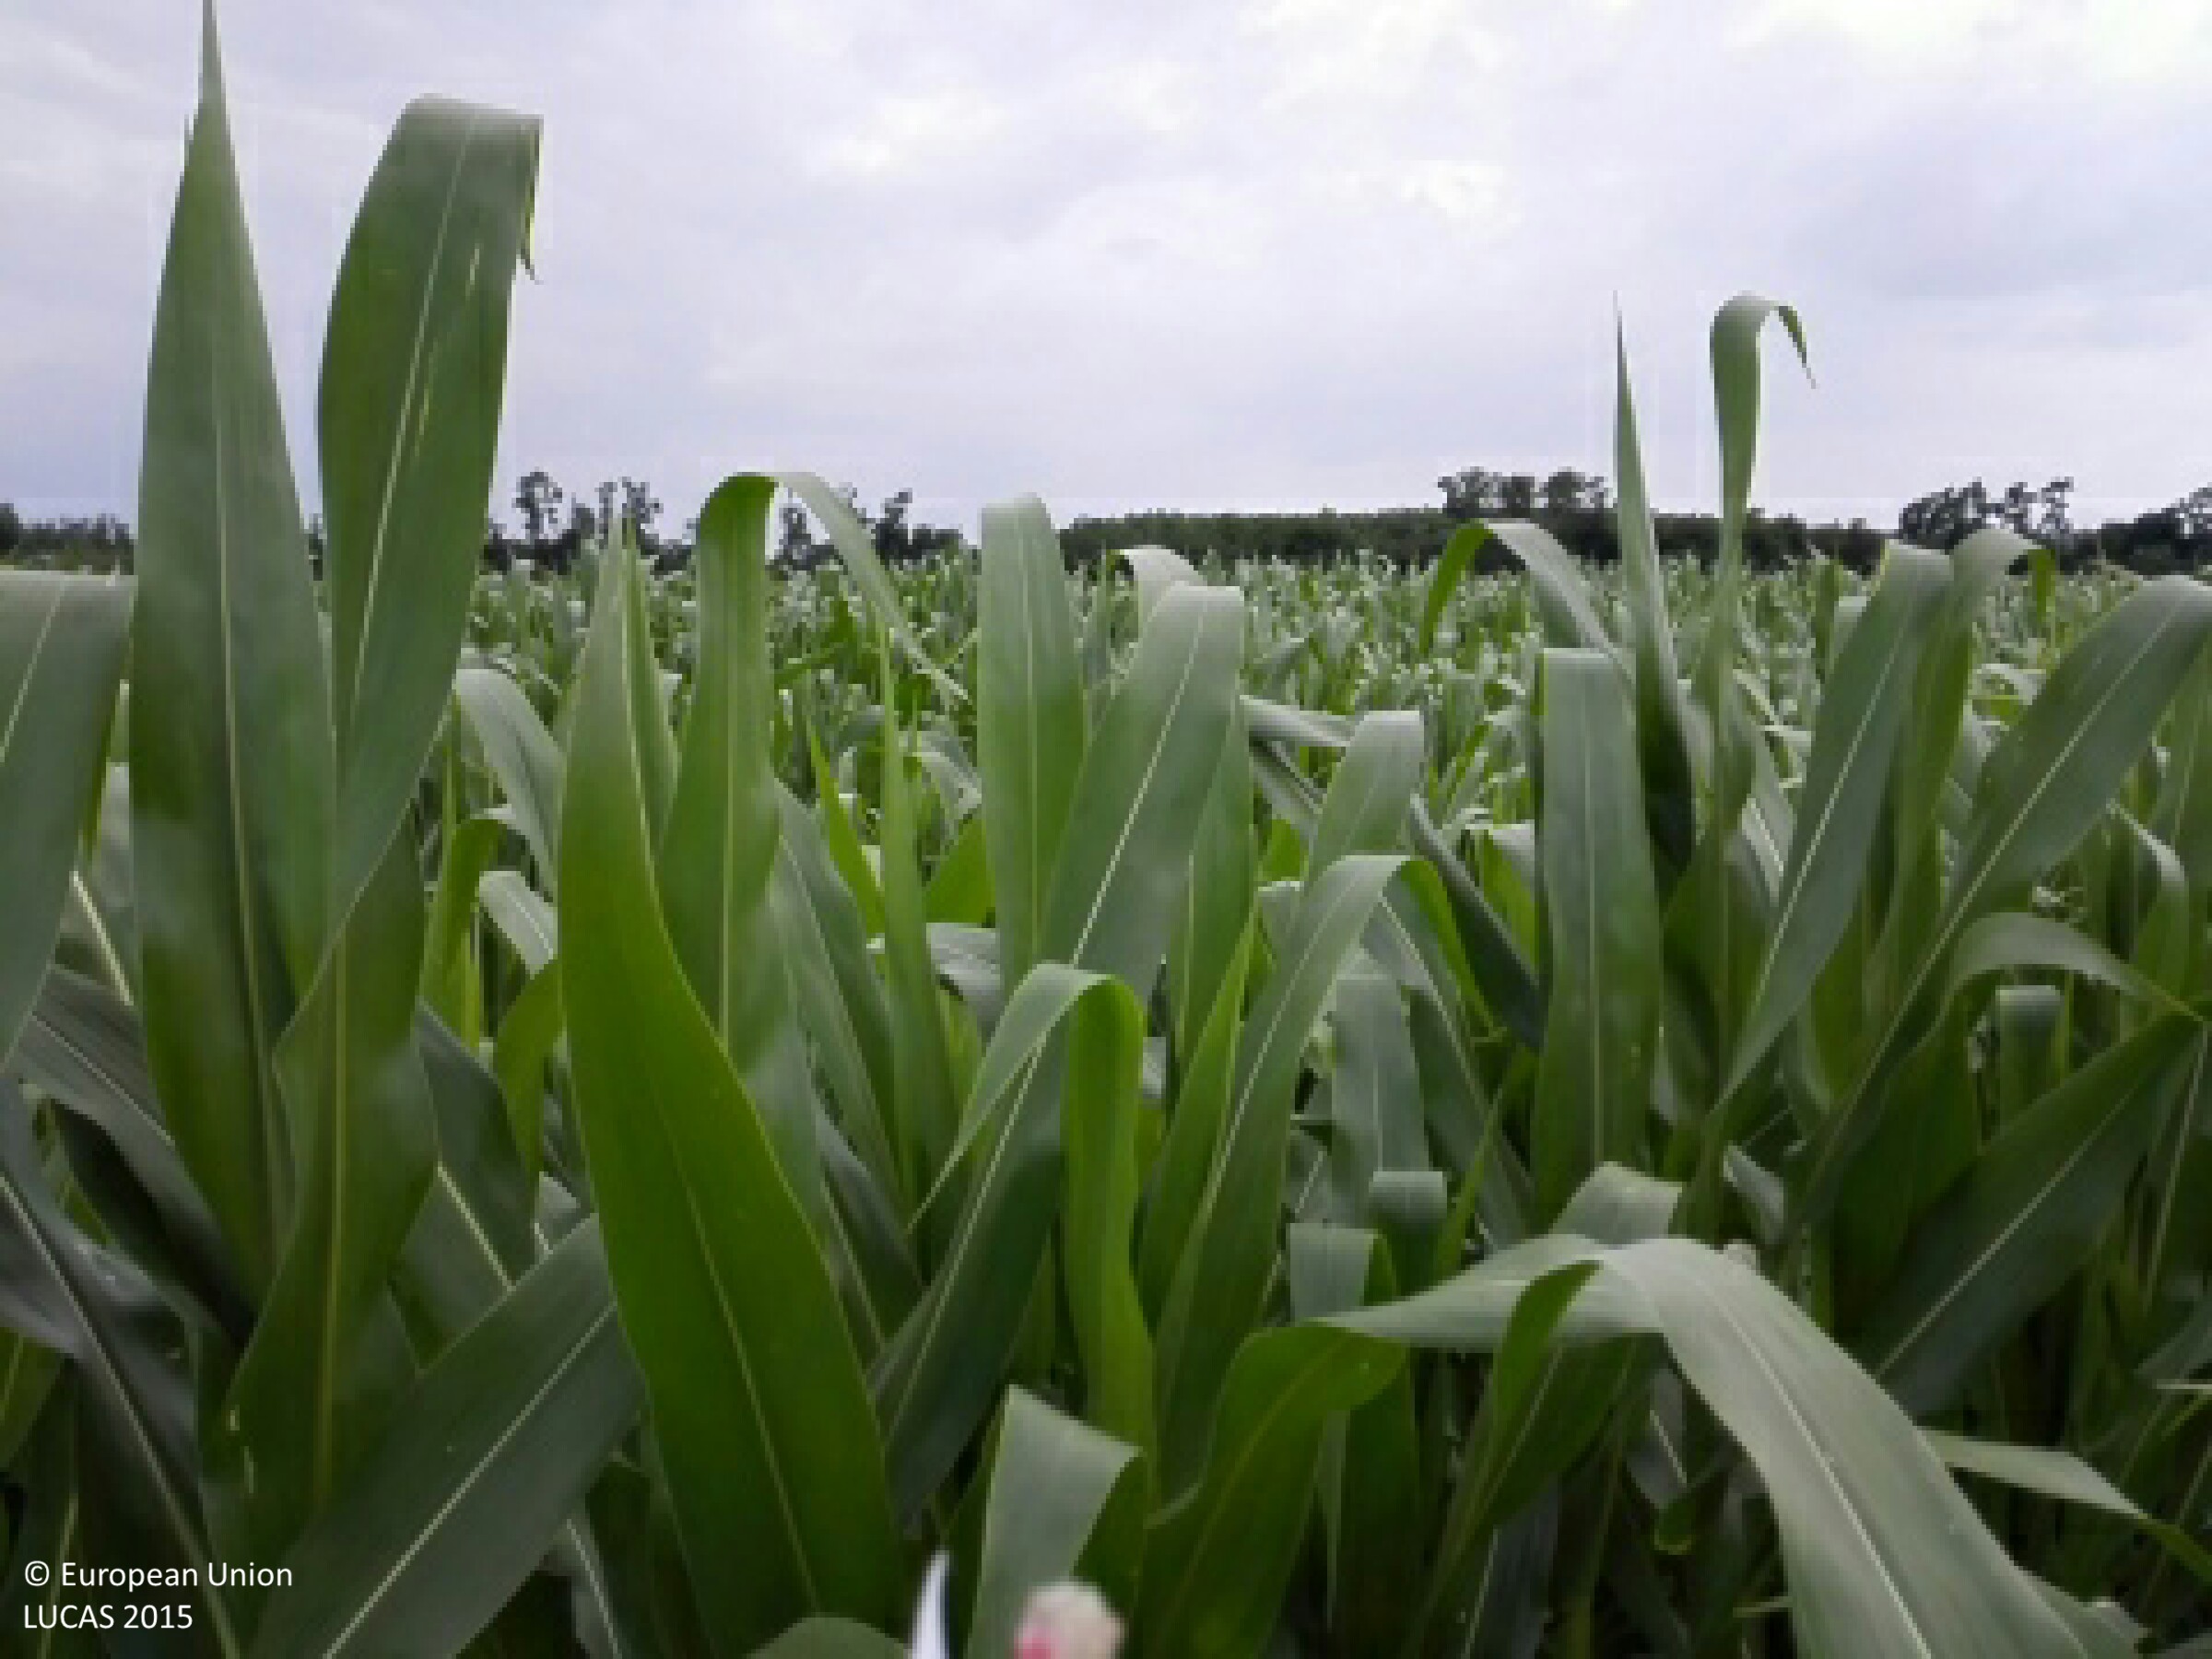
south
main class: Cropland
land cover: Maize
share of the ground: > 75 %
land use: Agriculture (excluding fallow land and kitchen gardens)
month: June
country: HU
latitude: 47.7148
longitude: 21.6289
